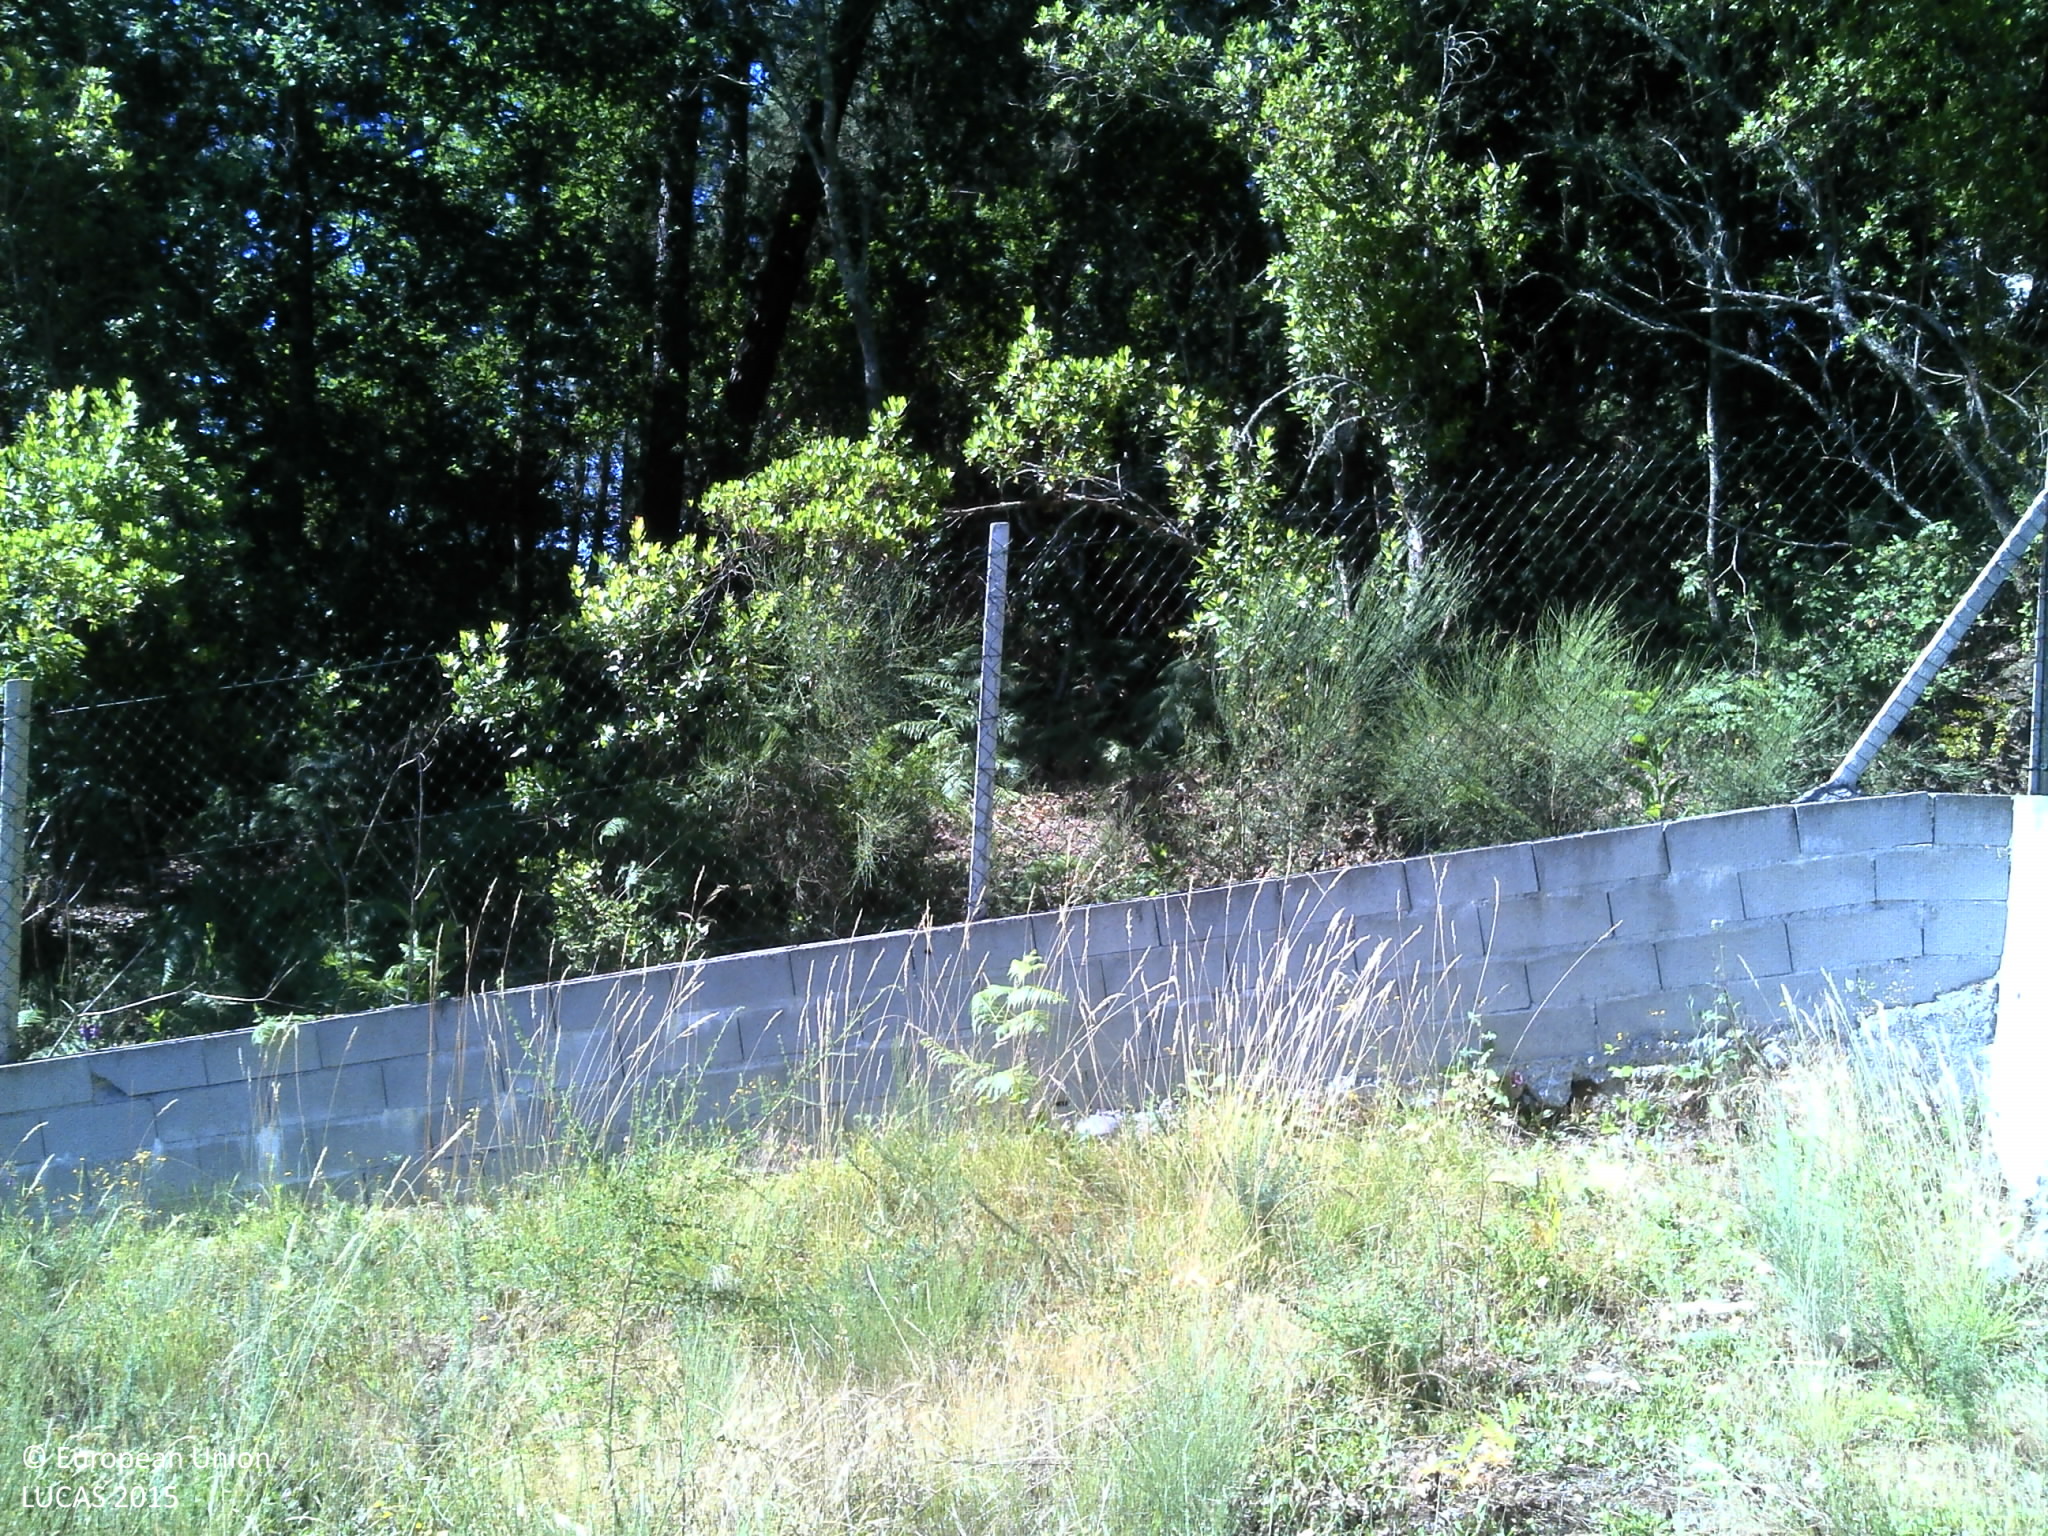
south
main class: Woodland
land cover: Broadleaved woodland
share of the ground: > 75 %
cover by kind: broadleaved forest trees 75 %, shrubs 25 %
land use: Forestry
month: June
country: PT
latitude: 40.6743
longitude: -8.0029
